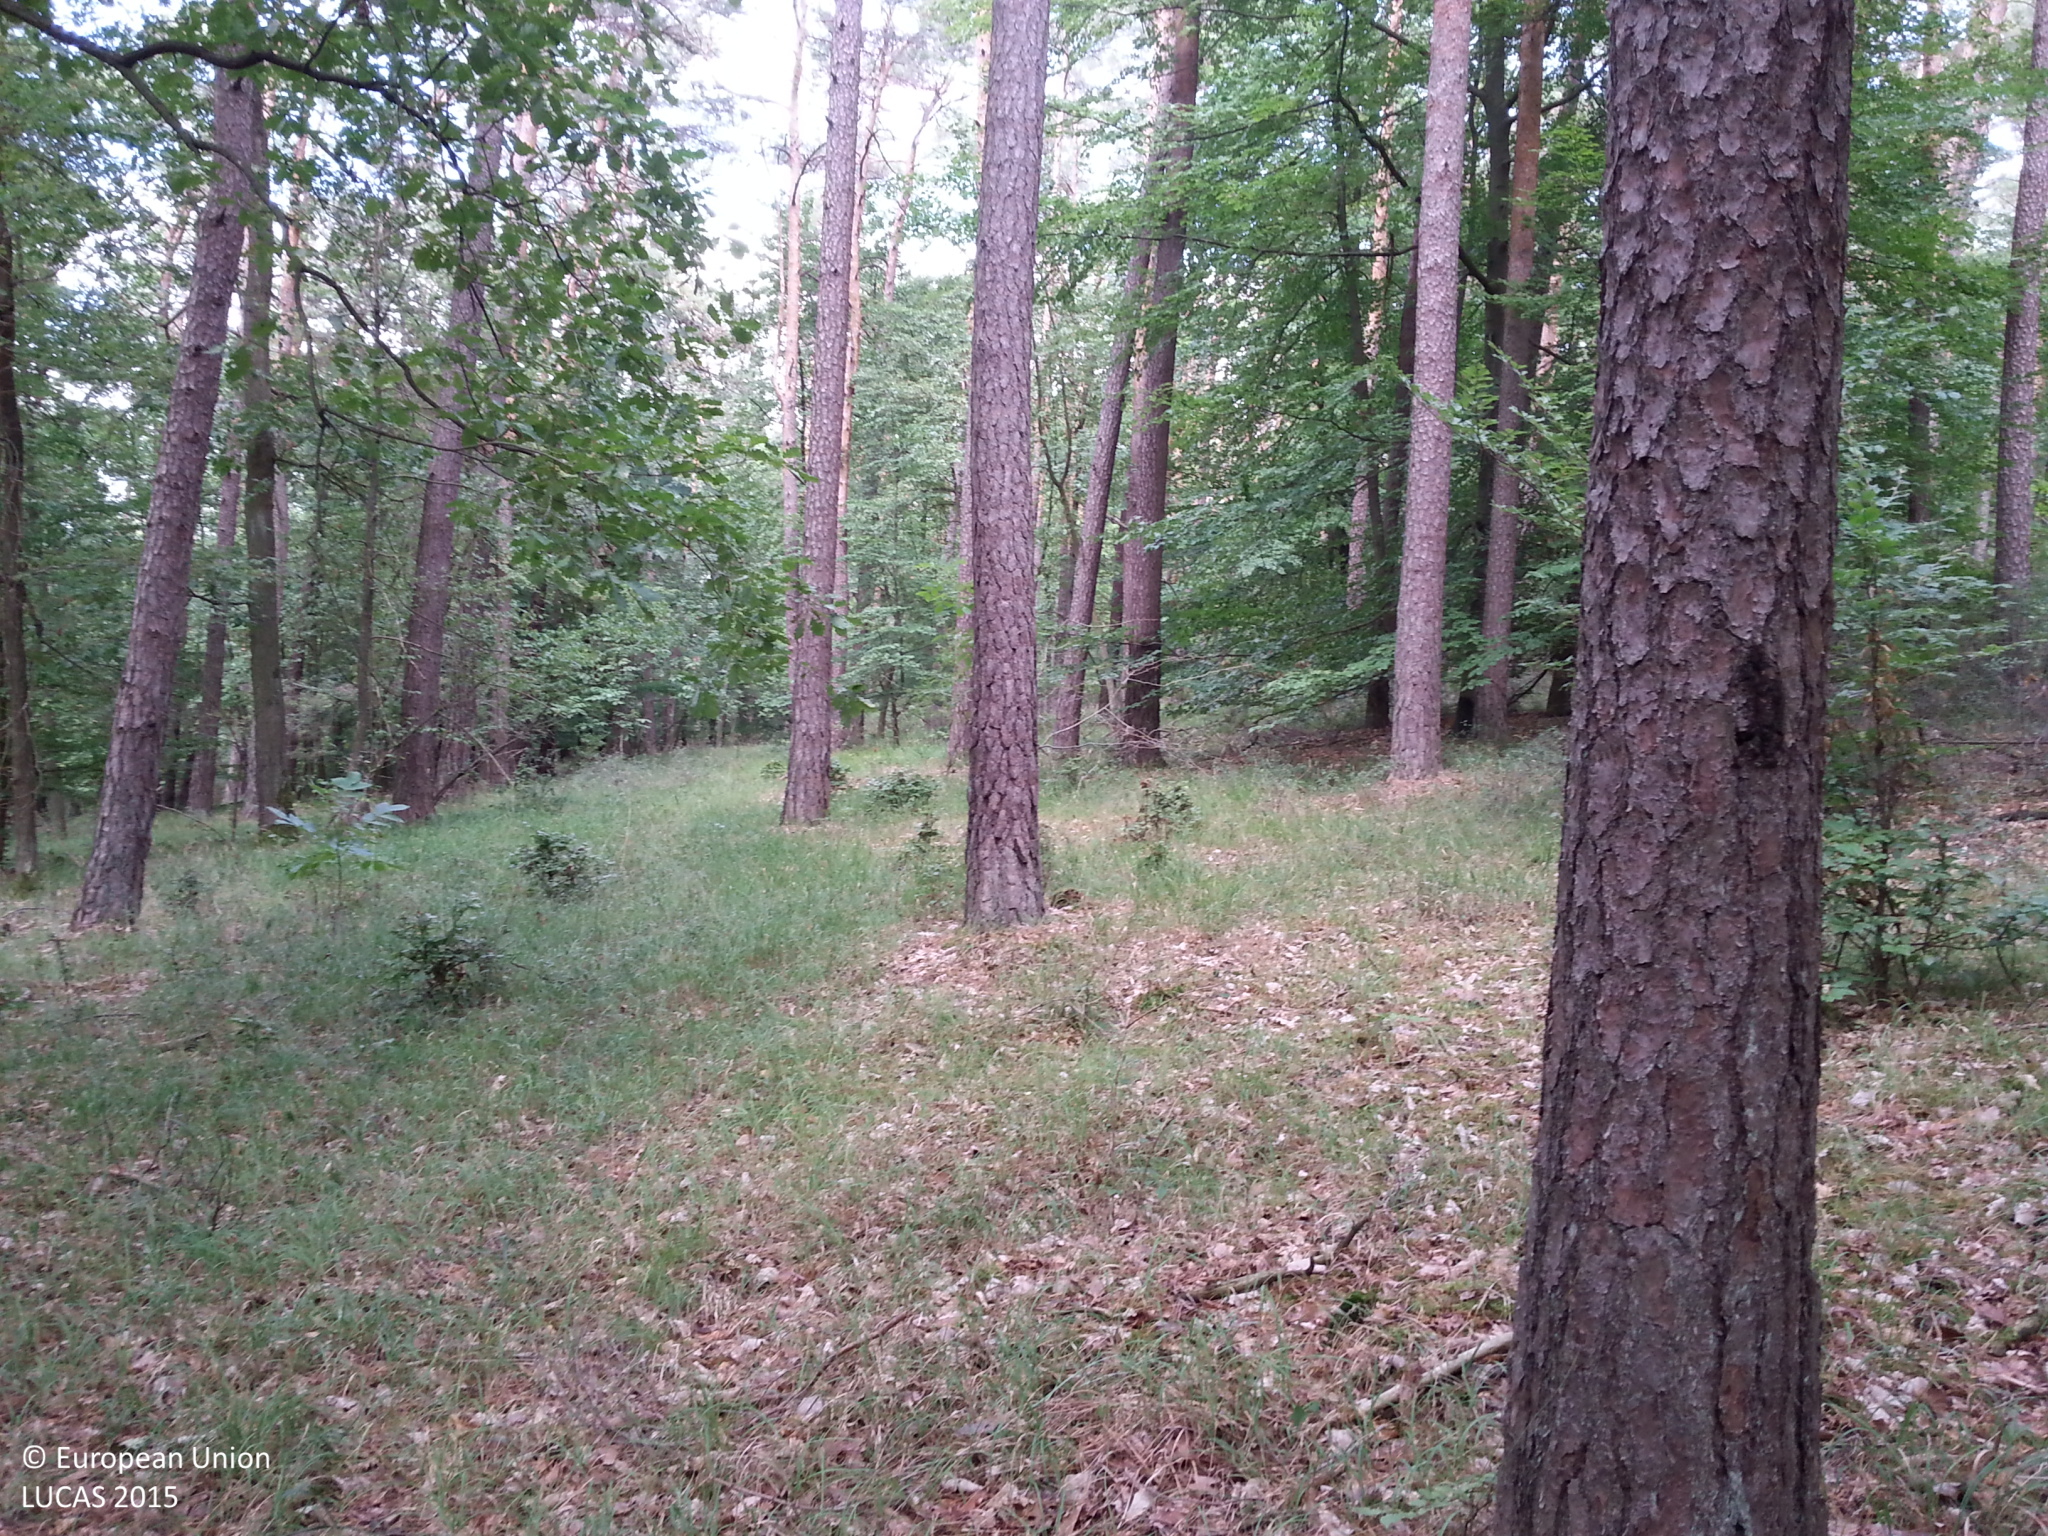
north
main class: Woodland
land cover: Pine dominated mixed woodland
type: hemiboreal forest and nemoral coniferous forest and mixed broadleaved-coniferous forest
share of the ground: > 75 %
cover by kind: coniferous forest trees 55 %, broadleaved forest trees 35 %, herbaceous plants 5 %, unconsolidated bare surface 5 %
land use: Forestry
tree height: > 5 m
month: September
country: DE
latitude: 49.6619
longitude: 9.5707
